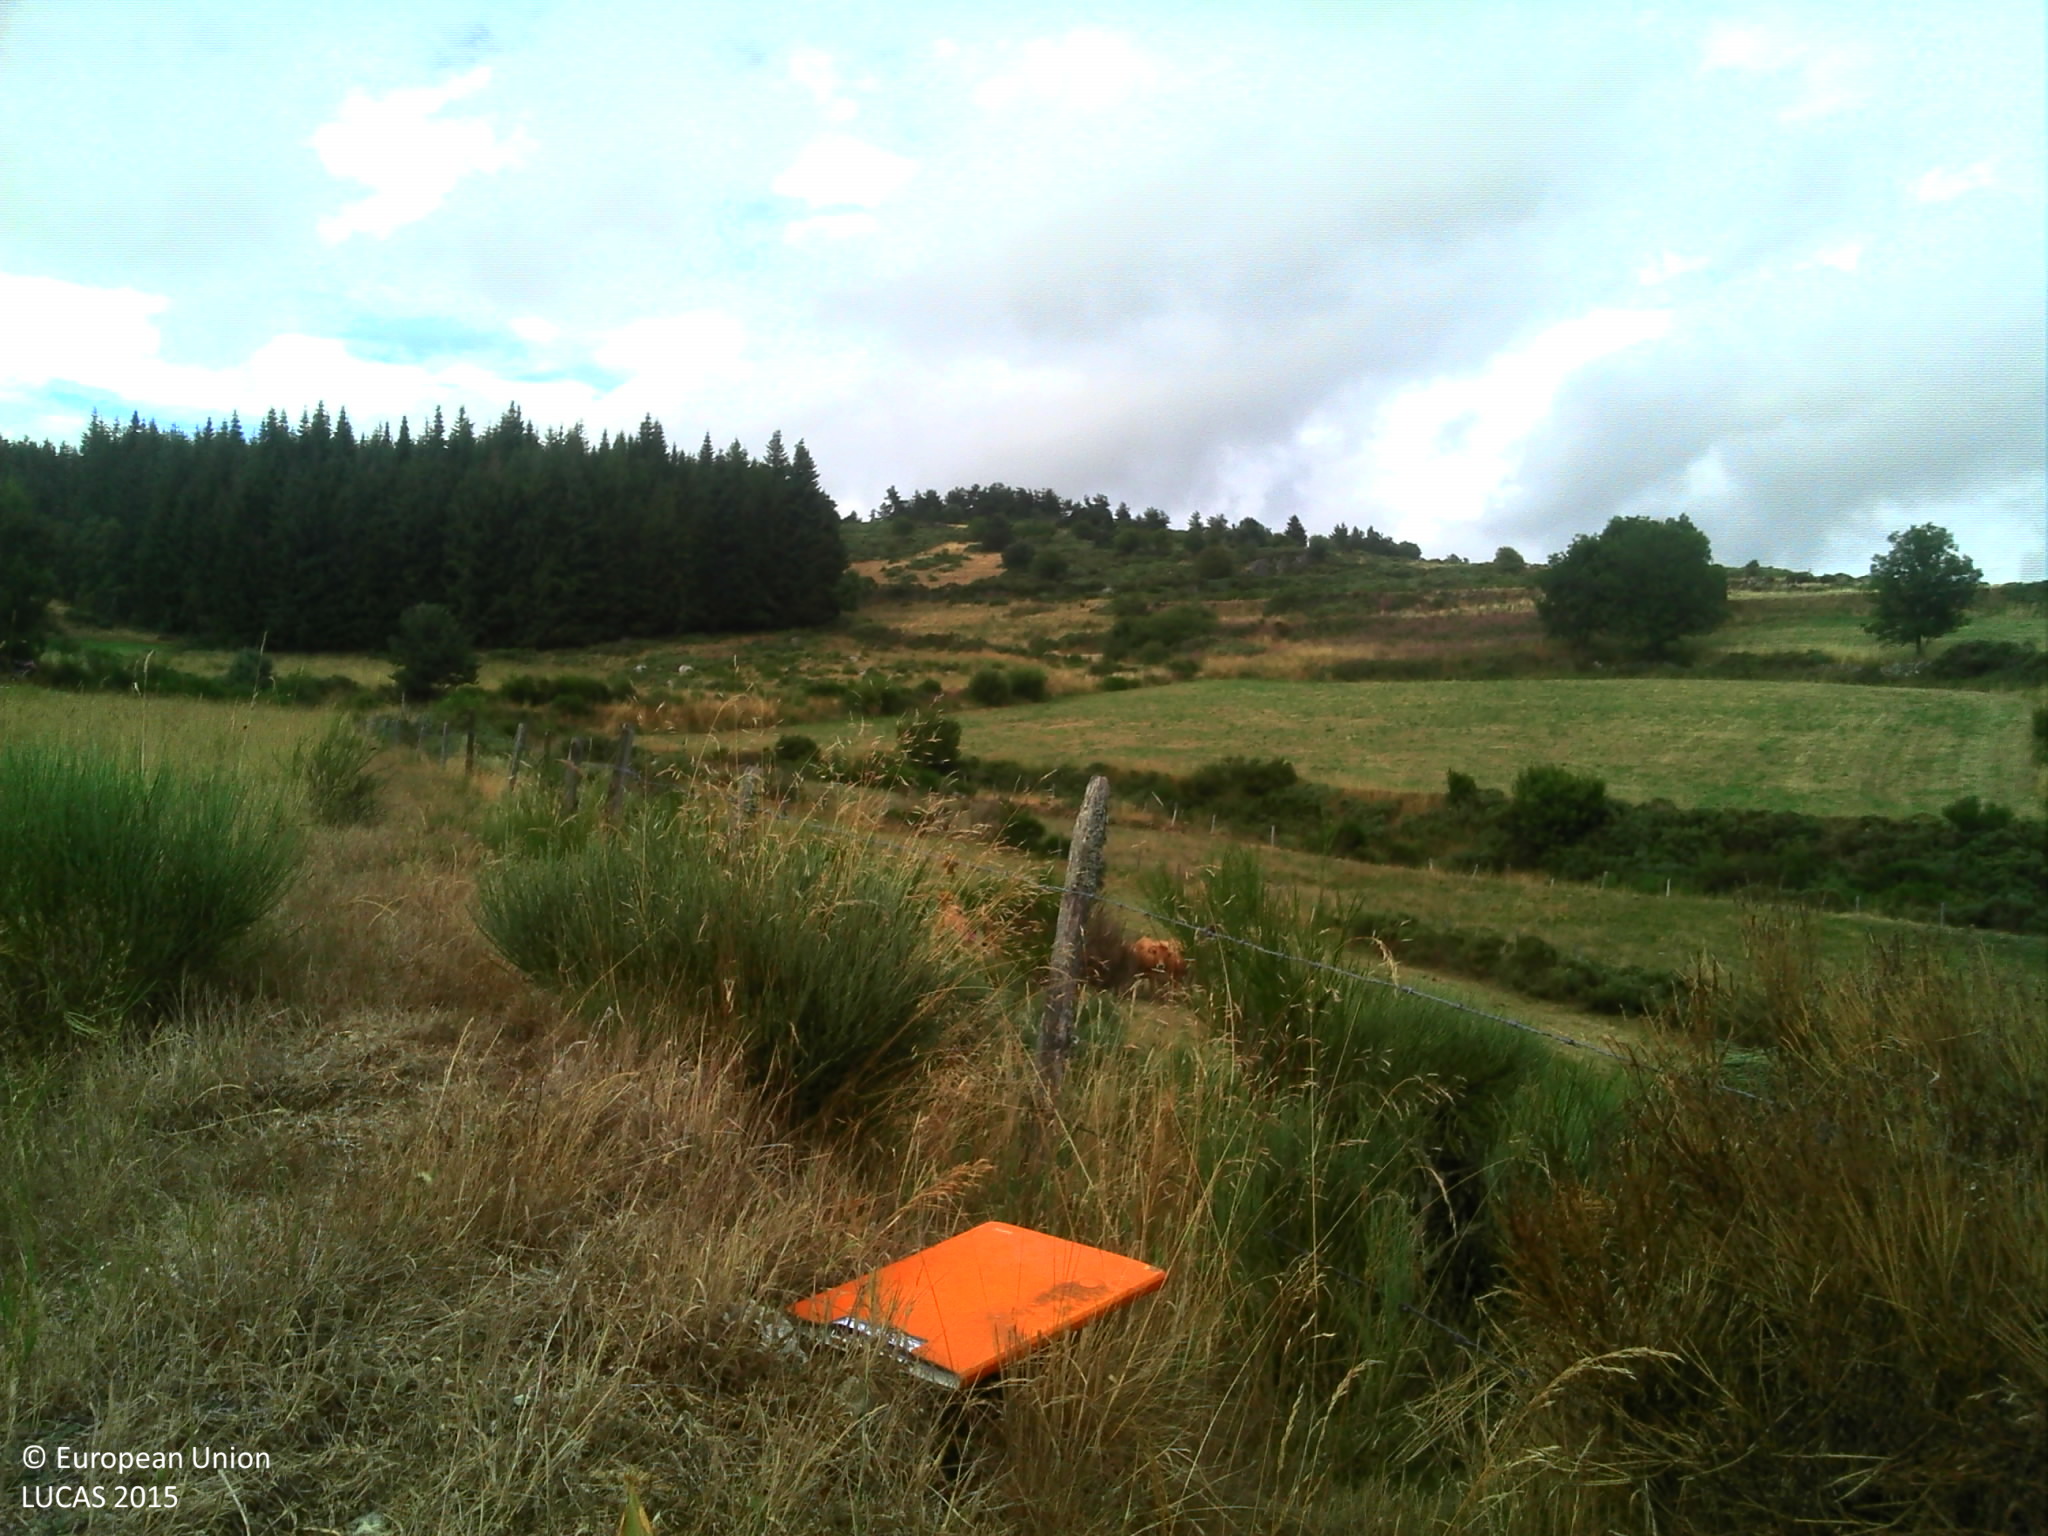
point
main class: Grassland
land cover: Grassland without tree/shrub cover
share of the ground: > 75 %
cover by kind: herbaceous plants 95 %, shrubs 5 %
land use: Agriculture (excluding fallow land and kitchen gardens)
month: July
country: FR
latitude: 44.7077
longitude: 3.5043
